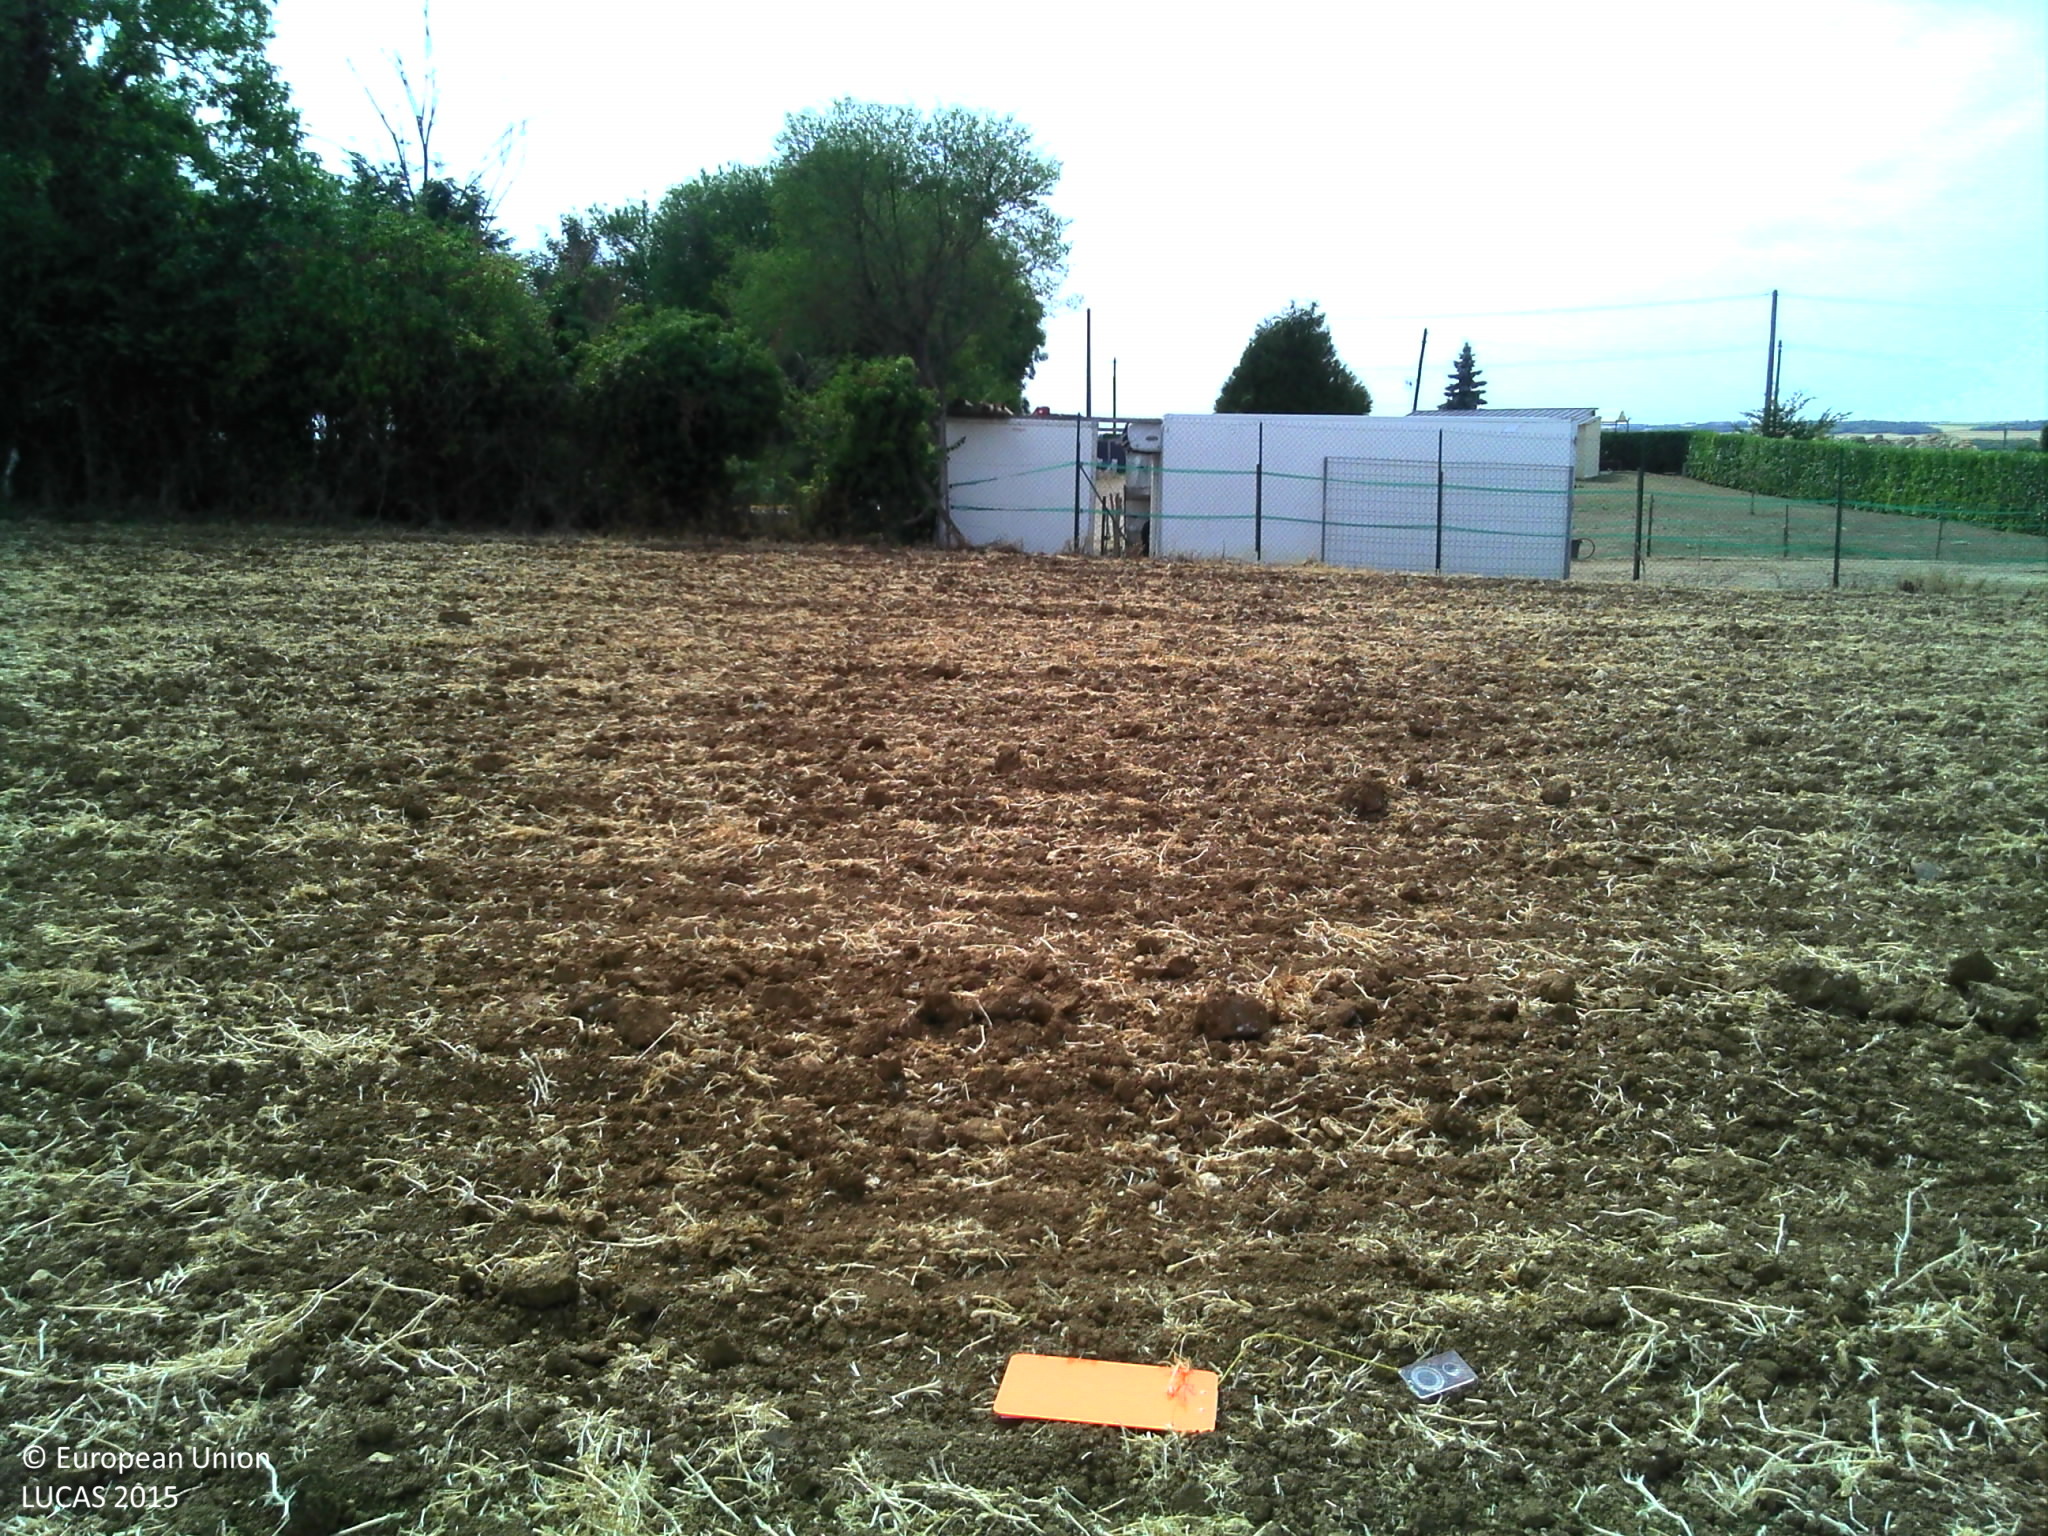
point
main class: Cropland
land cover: Dry pulses
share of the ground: > 75 %
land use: Agriculture (excluding fallow land and kitchen gardens)
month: August
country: FR
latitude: 48.2186
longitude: 2.4660
